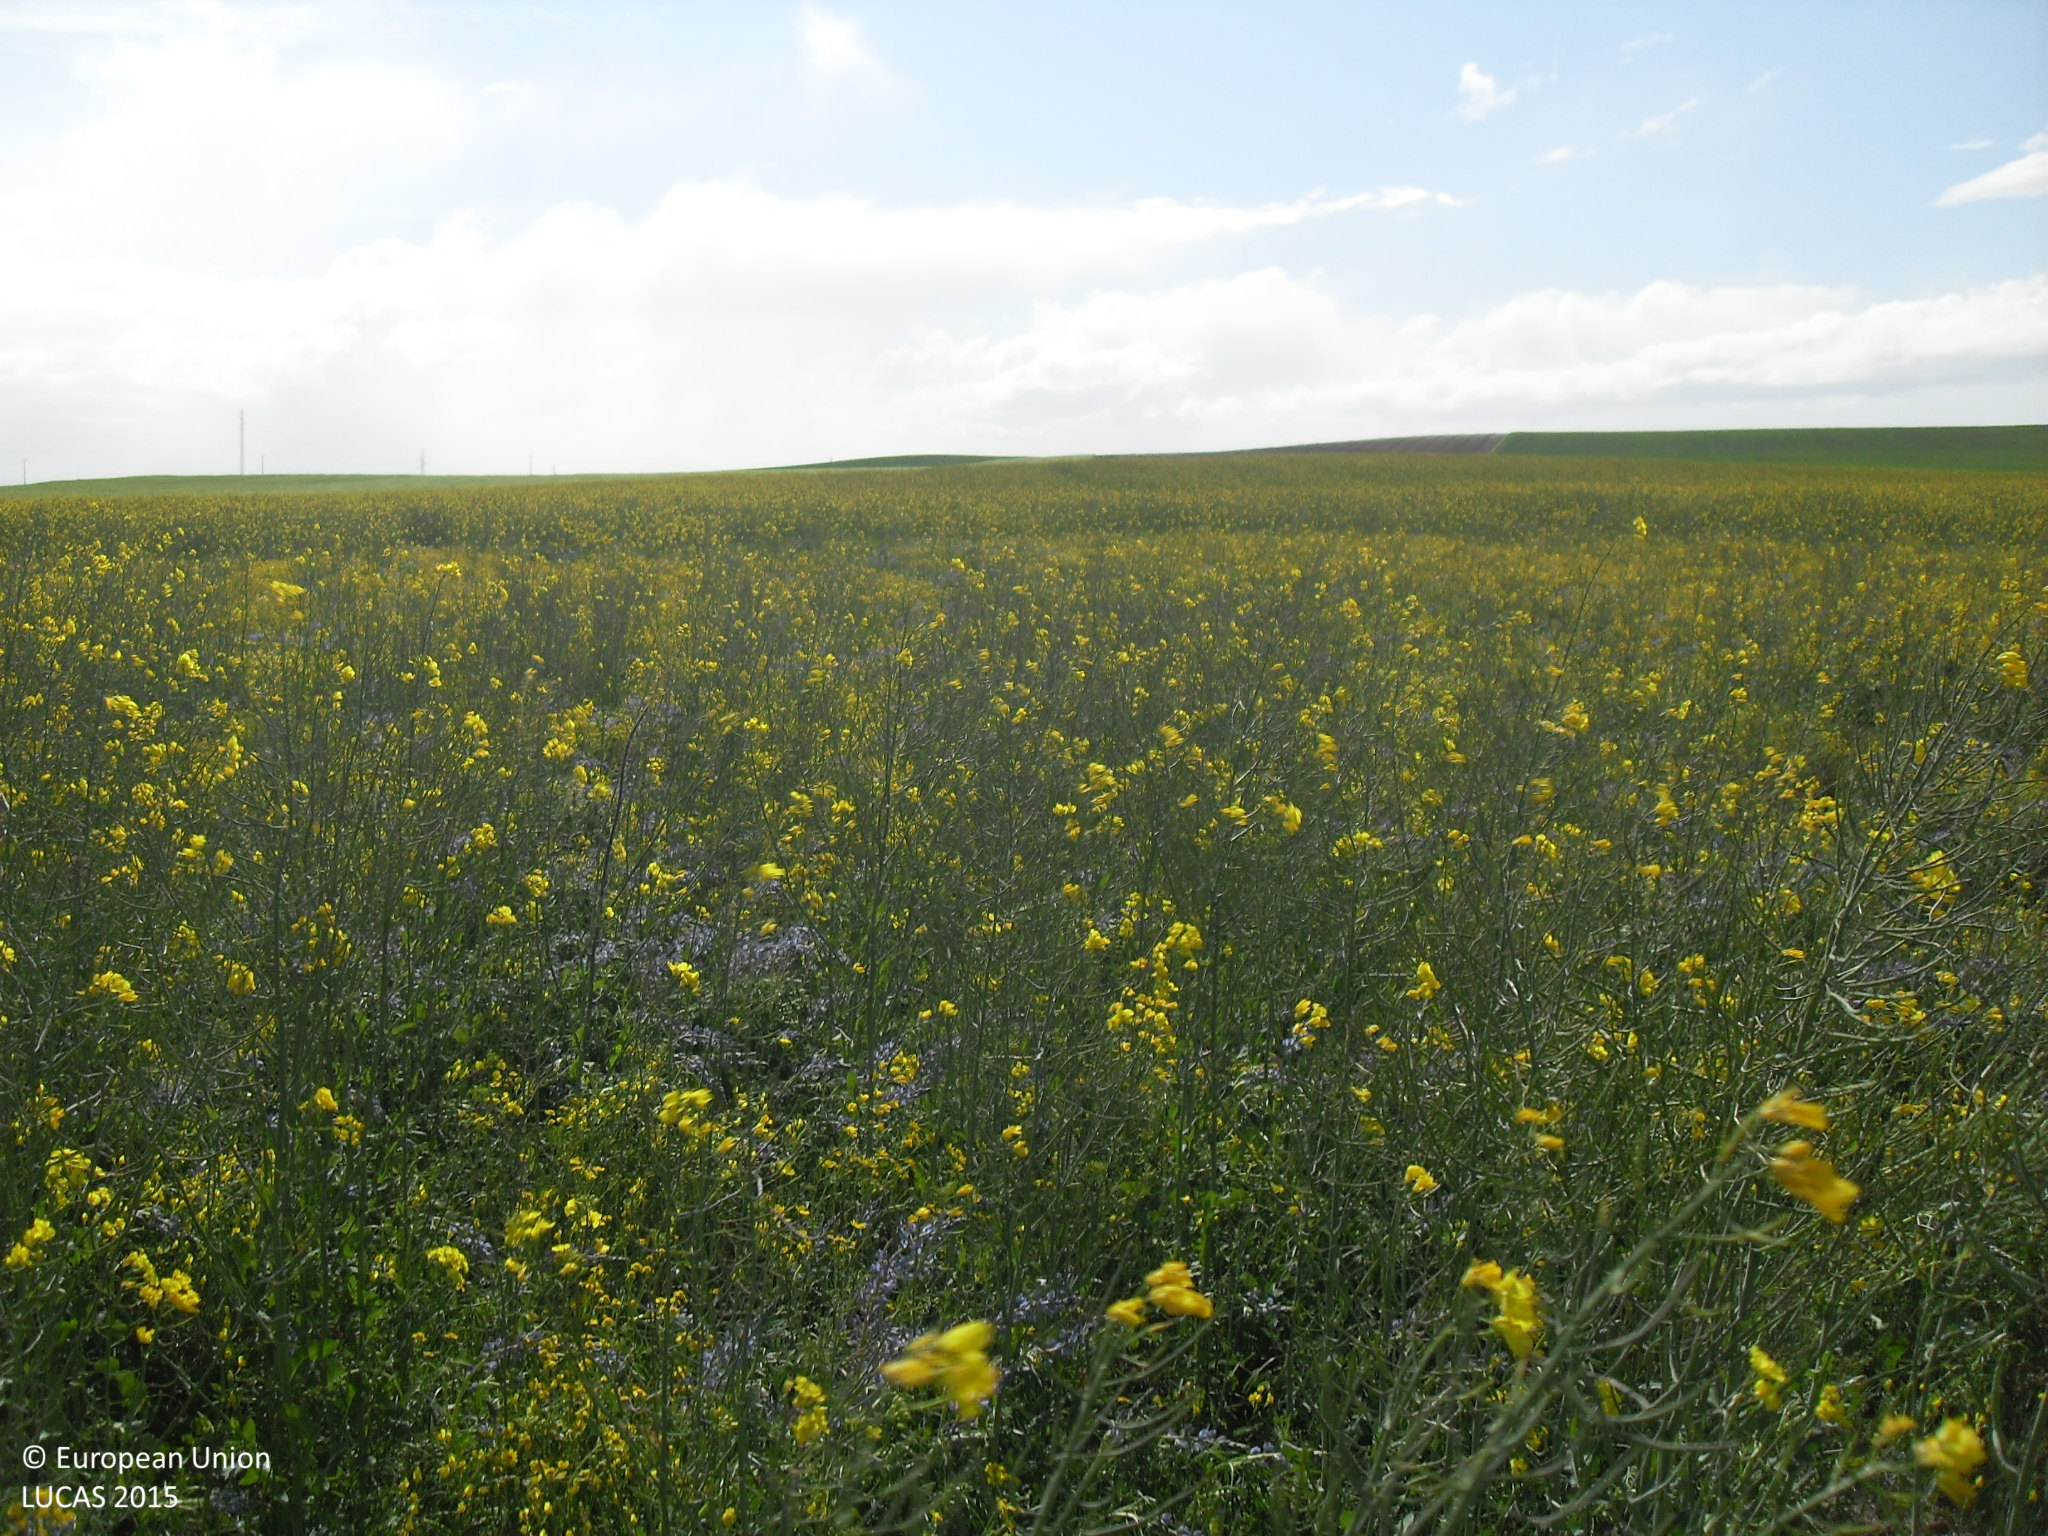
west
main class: Cropland
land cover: Rape and turnip rape
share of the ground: > 75 %
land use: Agriculture (excluding fallow land and kitchen gardens)
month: May
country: ES
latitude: 40.9355
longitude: -5.2839
